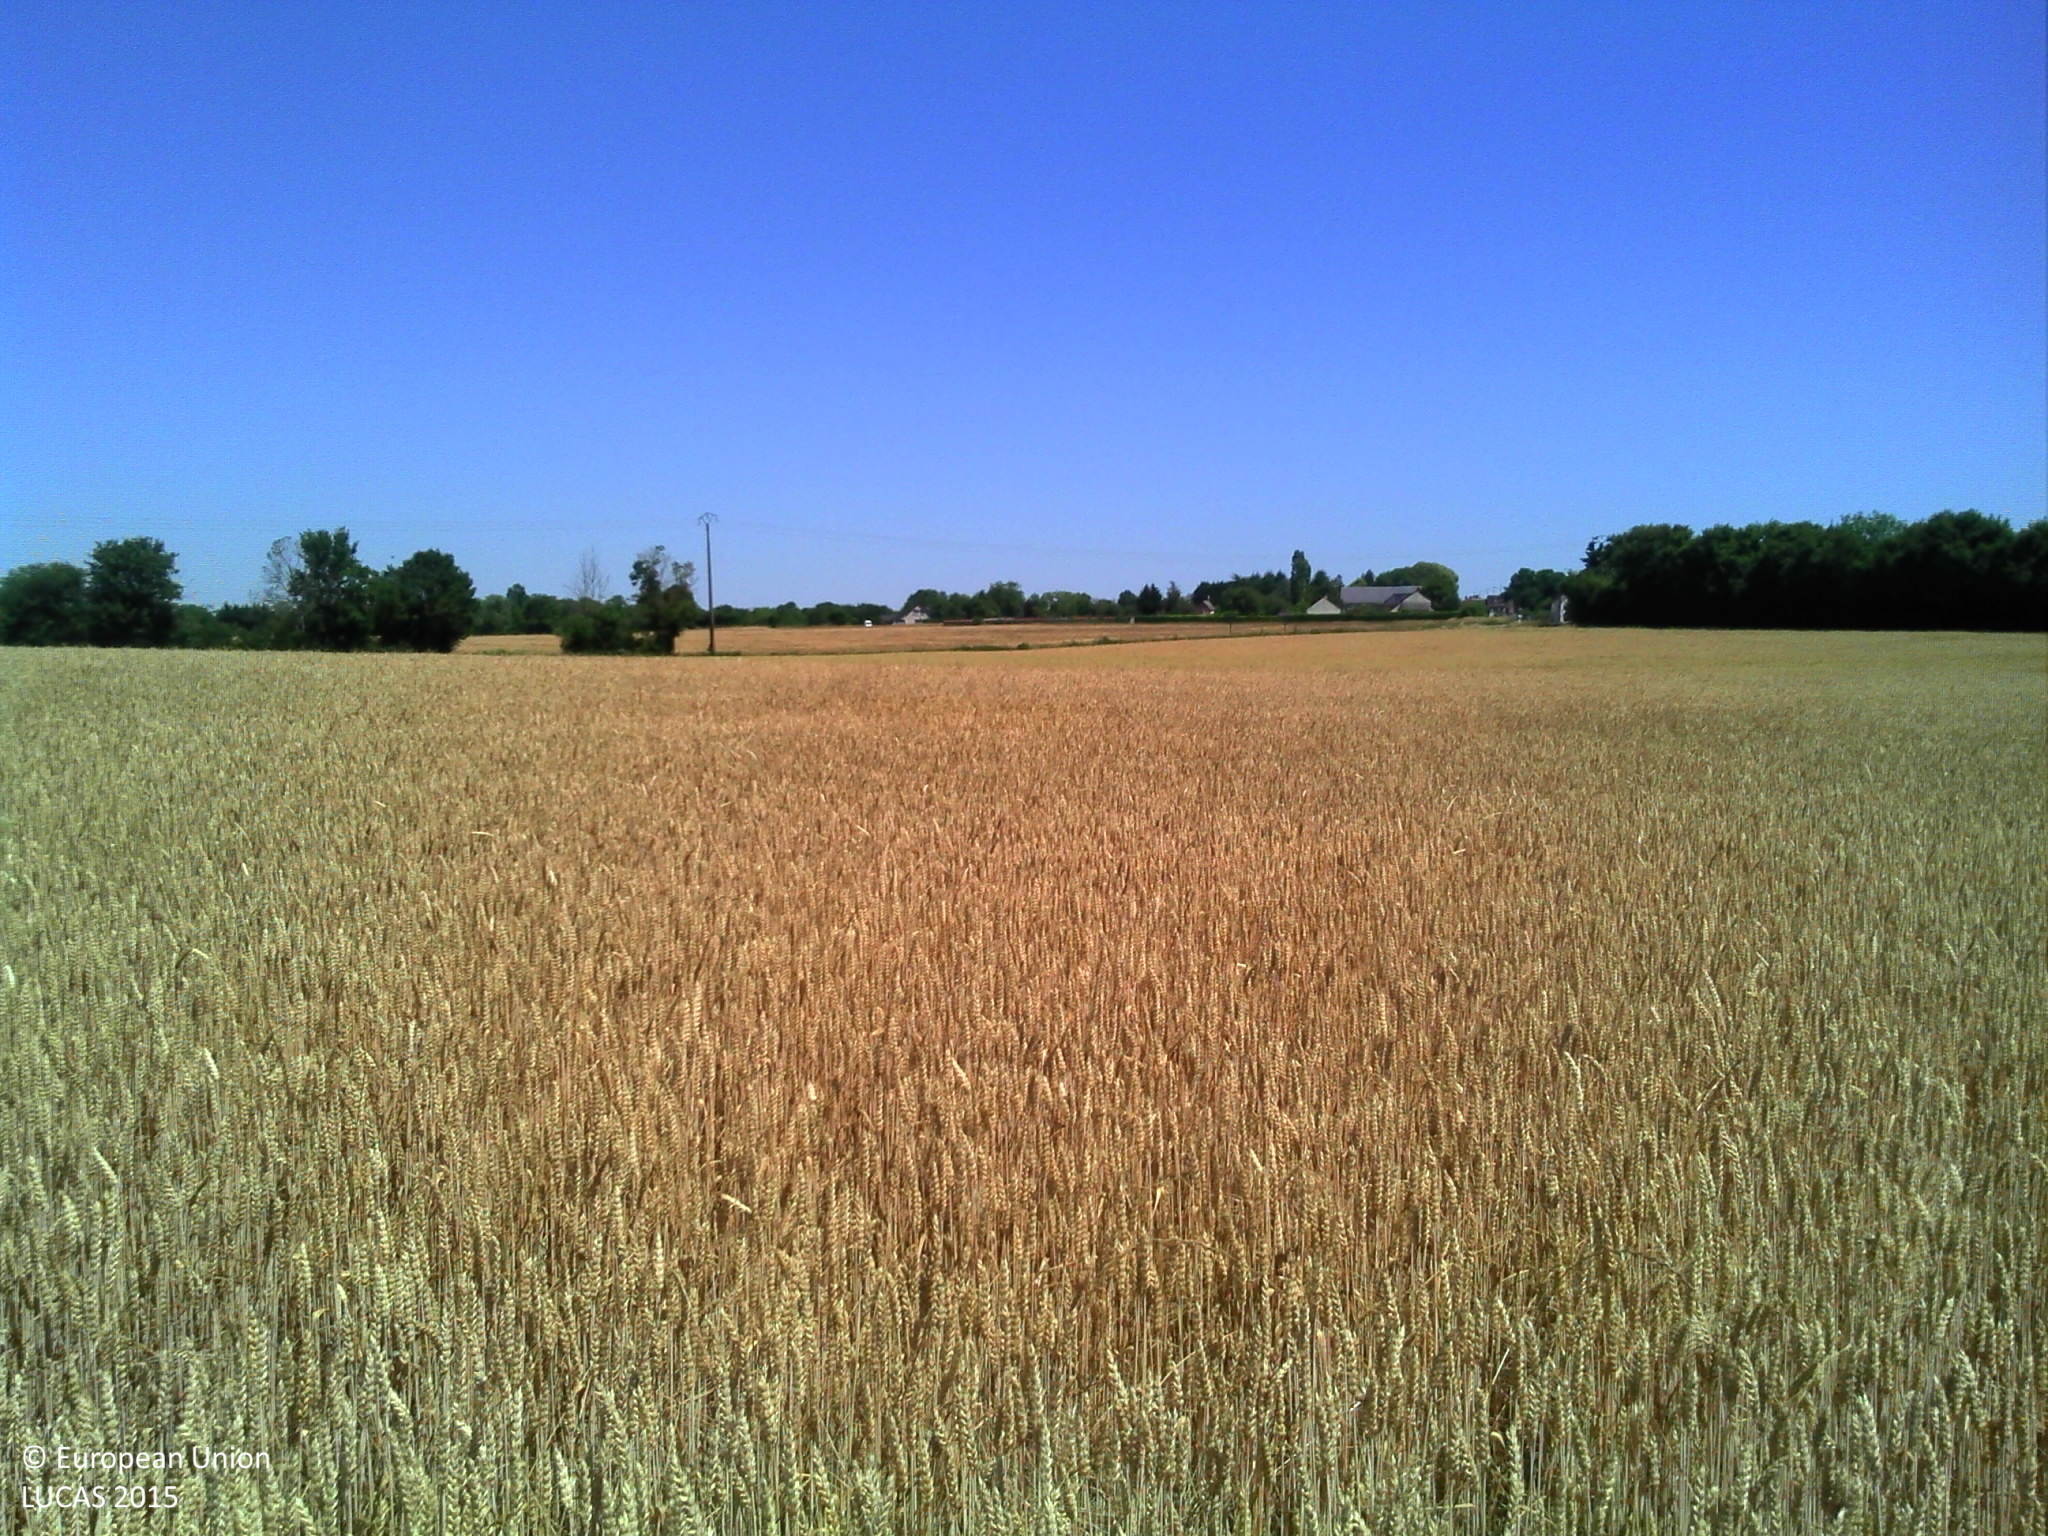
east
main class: Cropland
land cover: Common wheat
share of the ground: > 75 %
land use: Agriculture (excluding fallow land and kitchen gardens)
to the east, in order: Common wheat; Electric lines; Ditches and canals; Grass margins; Paved roads, cycling and walking lanes; Grass margins; Ditches and canals; Grassland without tree/shrub cover; Triticale
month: June
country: FR
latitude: 47.6136
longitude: 2.8758
